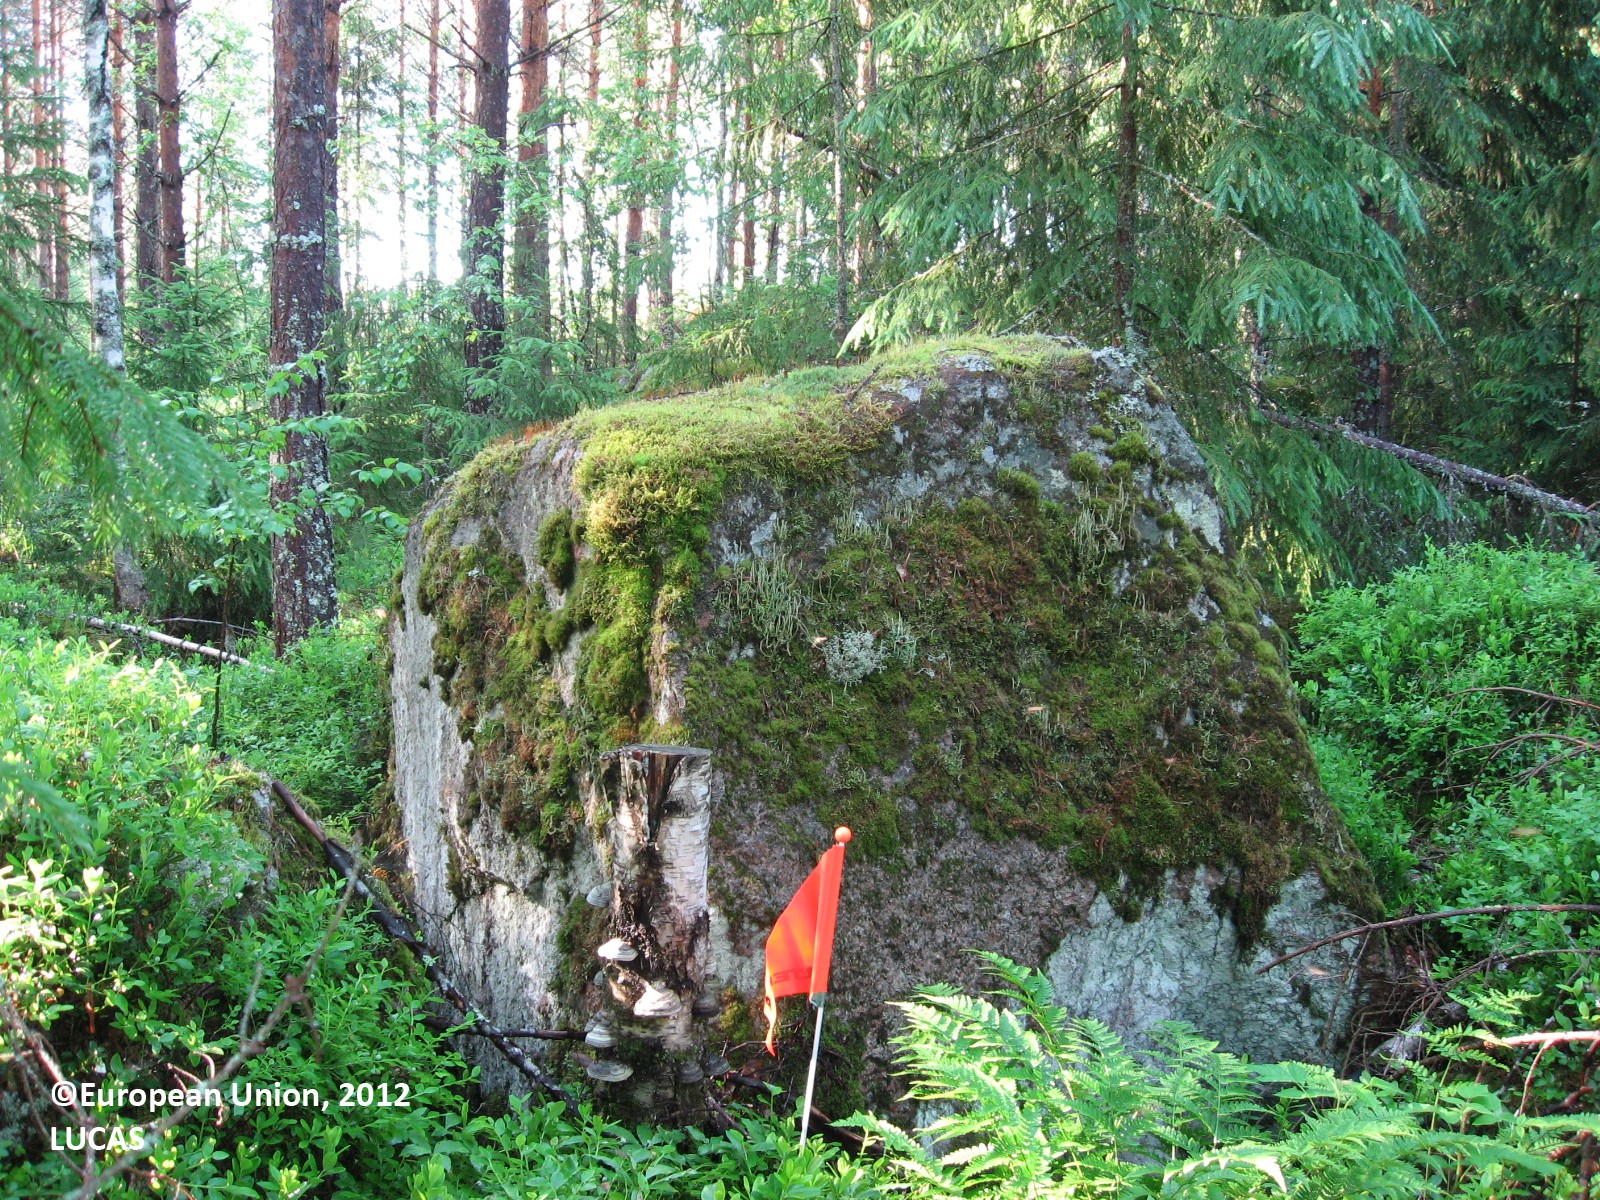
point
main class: Woodland
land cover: Other coniferous woodland
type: boreal forest
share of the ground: 25 - 50 %
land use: Forestry
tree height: > 5 m
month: June
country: FI
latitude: 60.6394
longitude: 26.3316
